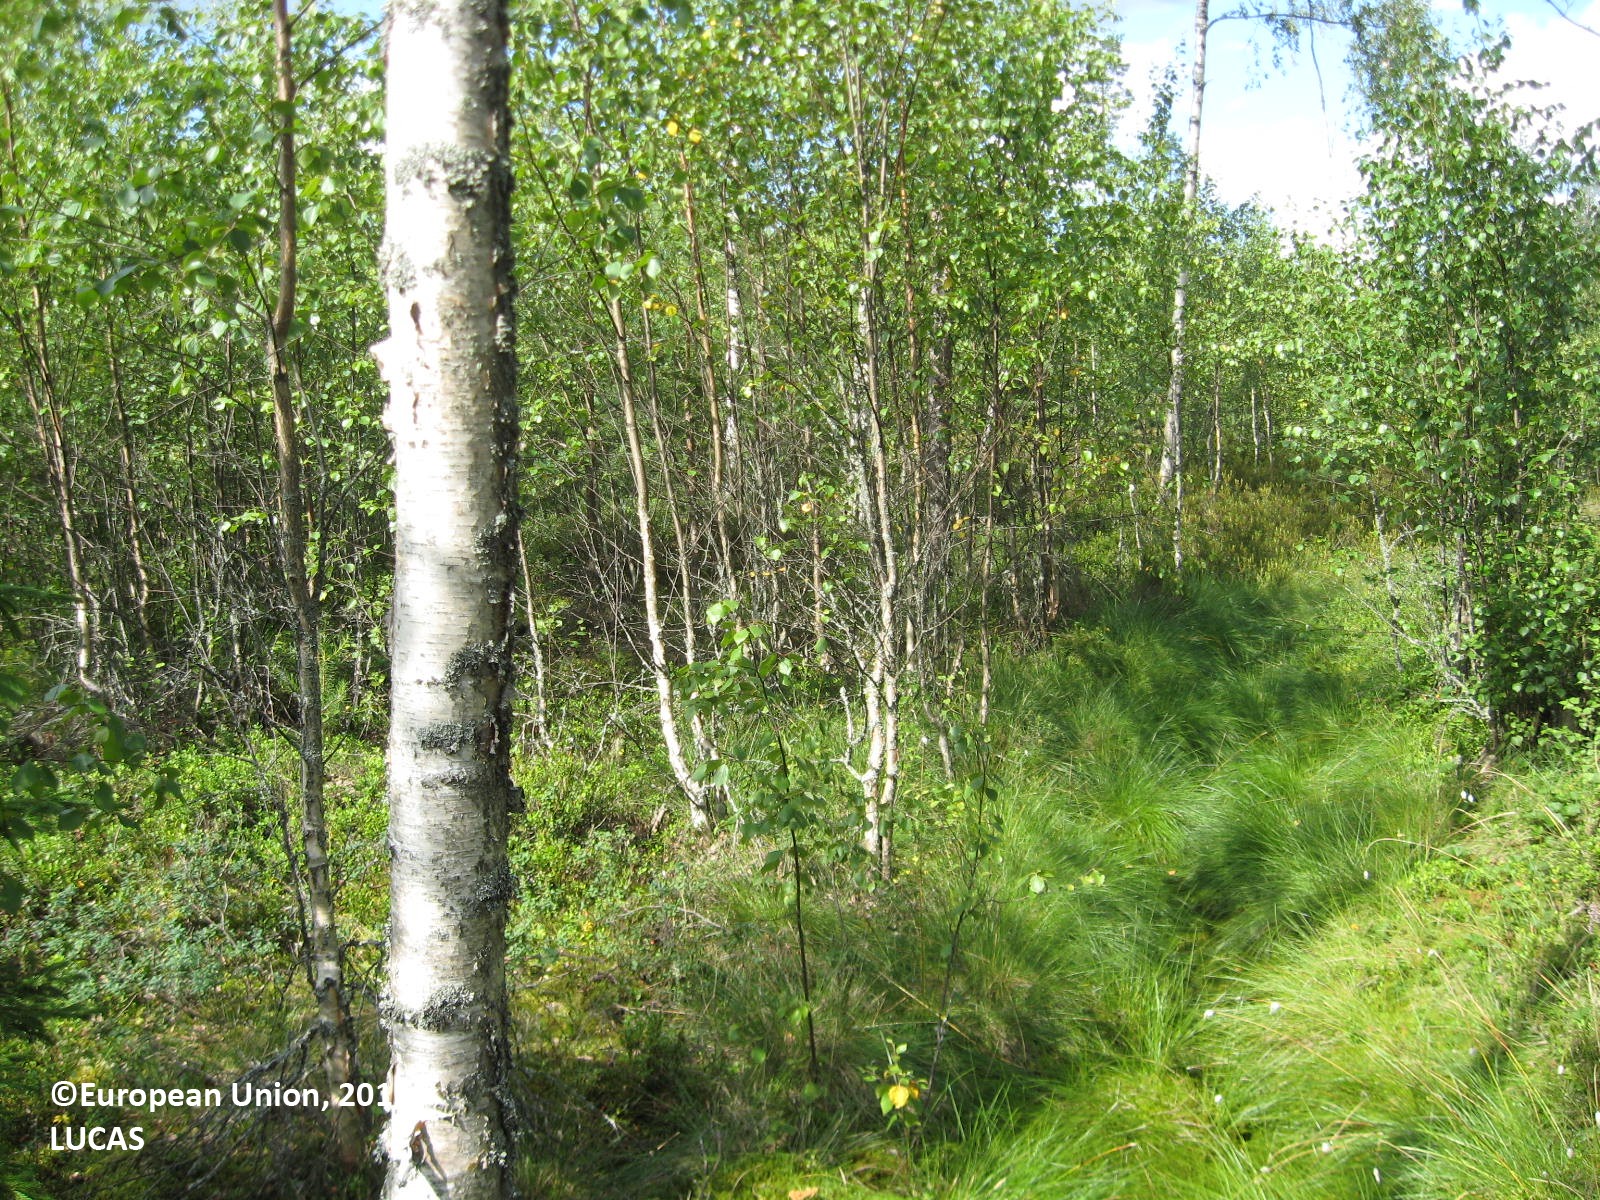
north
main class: Woodland
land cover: Pine dominated mixed woodland
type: boreal forest
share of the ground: > 75 %
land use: Forestry
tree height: > 5 m
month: July
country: FI
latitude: 62.0243
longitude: 22.6158
